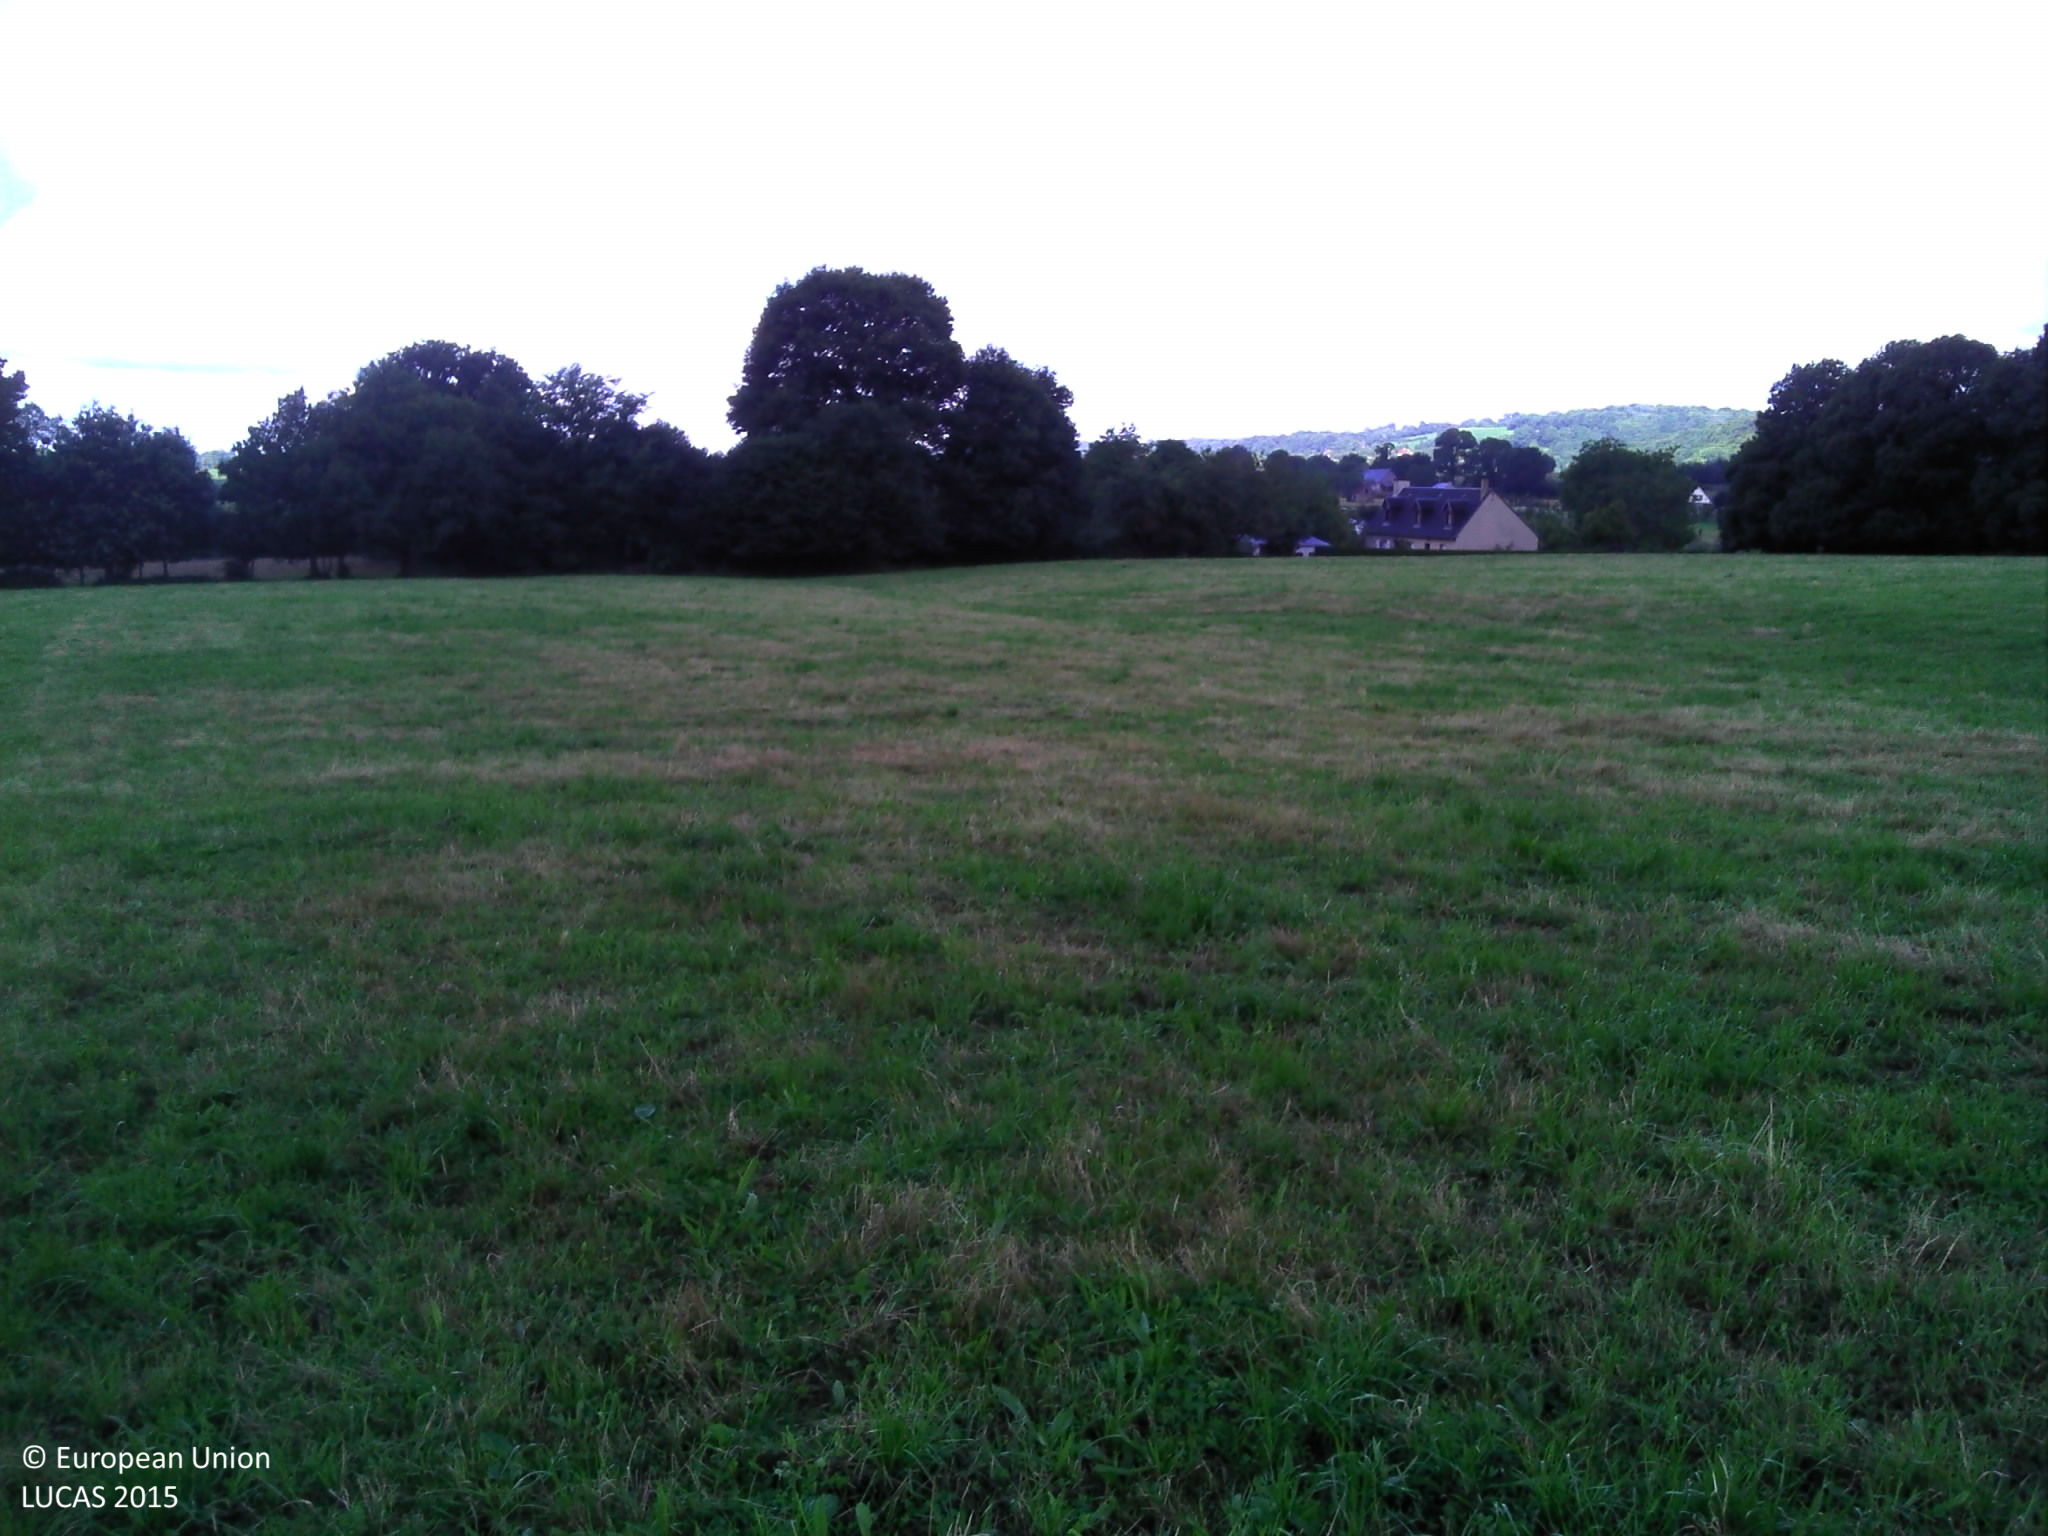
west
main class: Grassland
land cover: Grassland without tree/shrub cover
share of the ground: > 75 %
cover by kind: herbaceous plants 100 %
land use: Agriculture (excluding fallow land and kitchen gardens)
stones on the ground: < 10 %
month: July
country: FR
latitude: 48.7371
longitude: -1.2348
